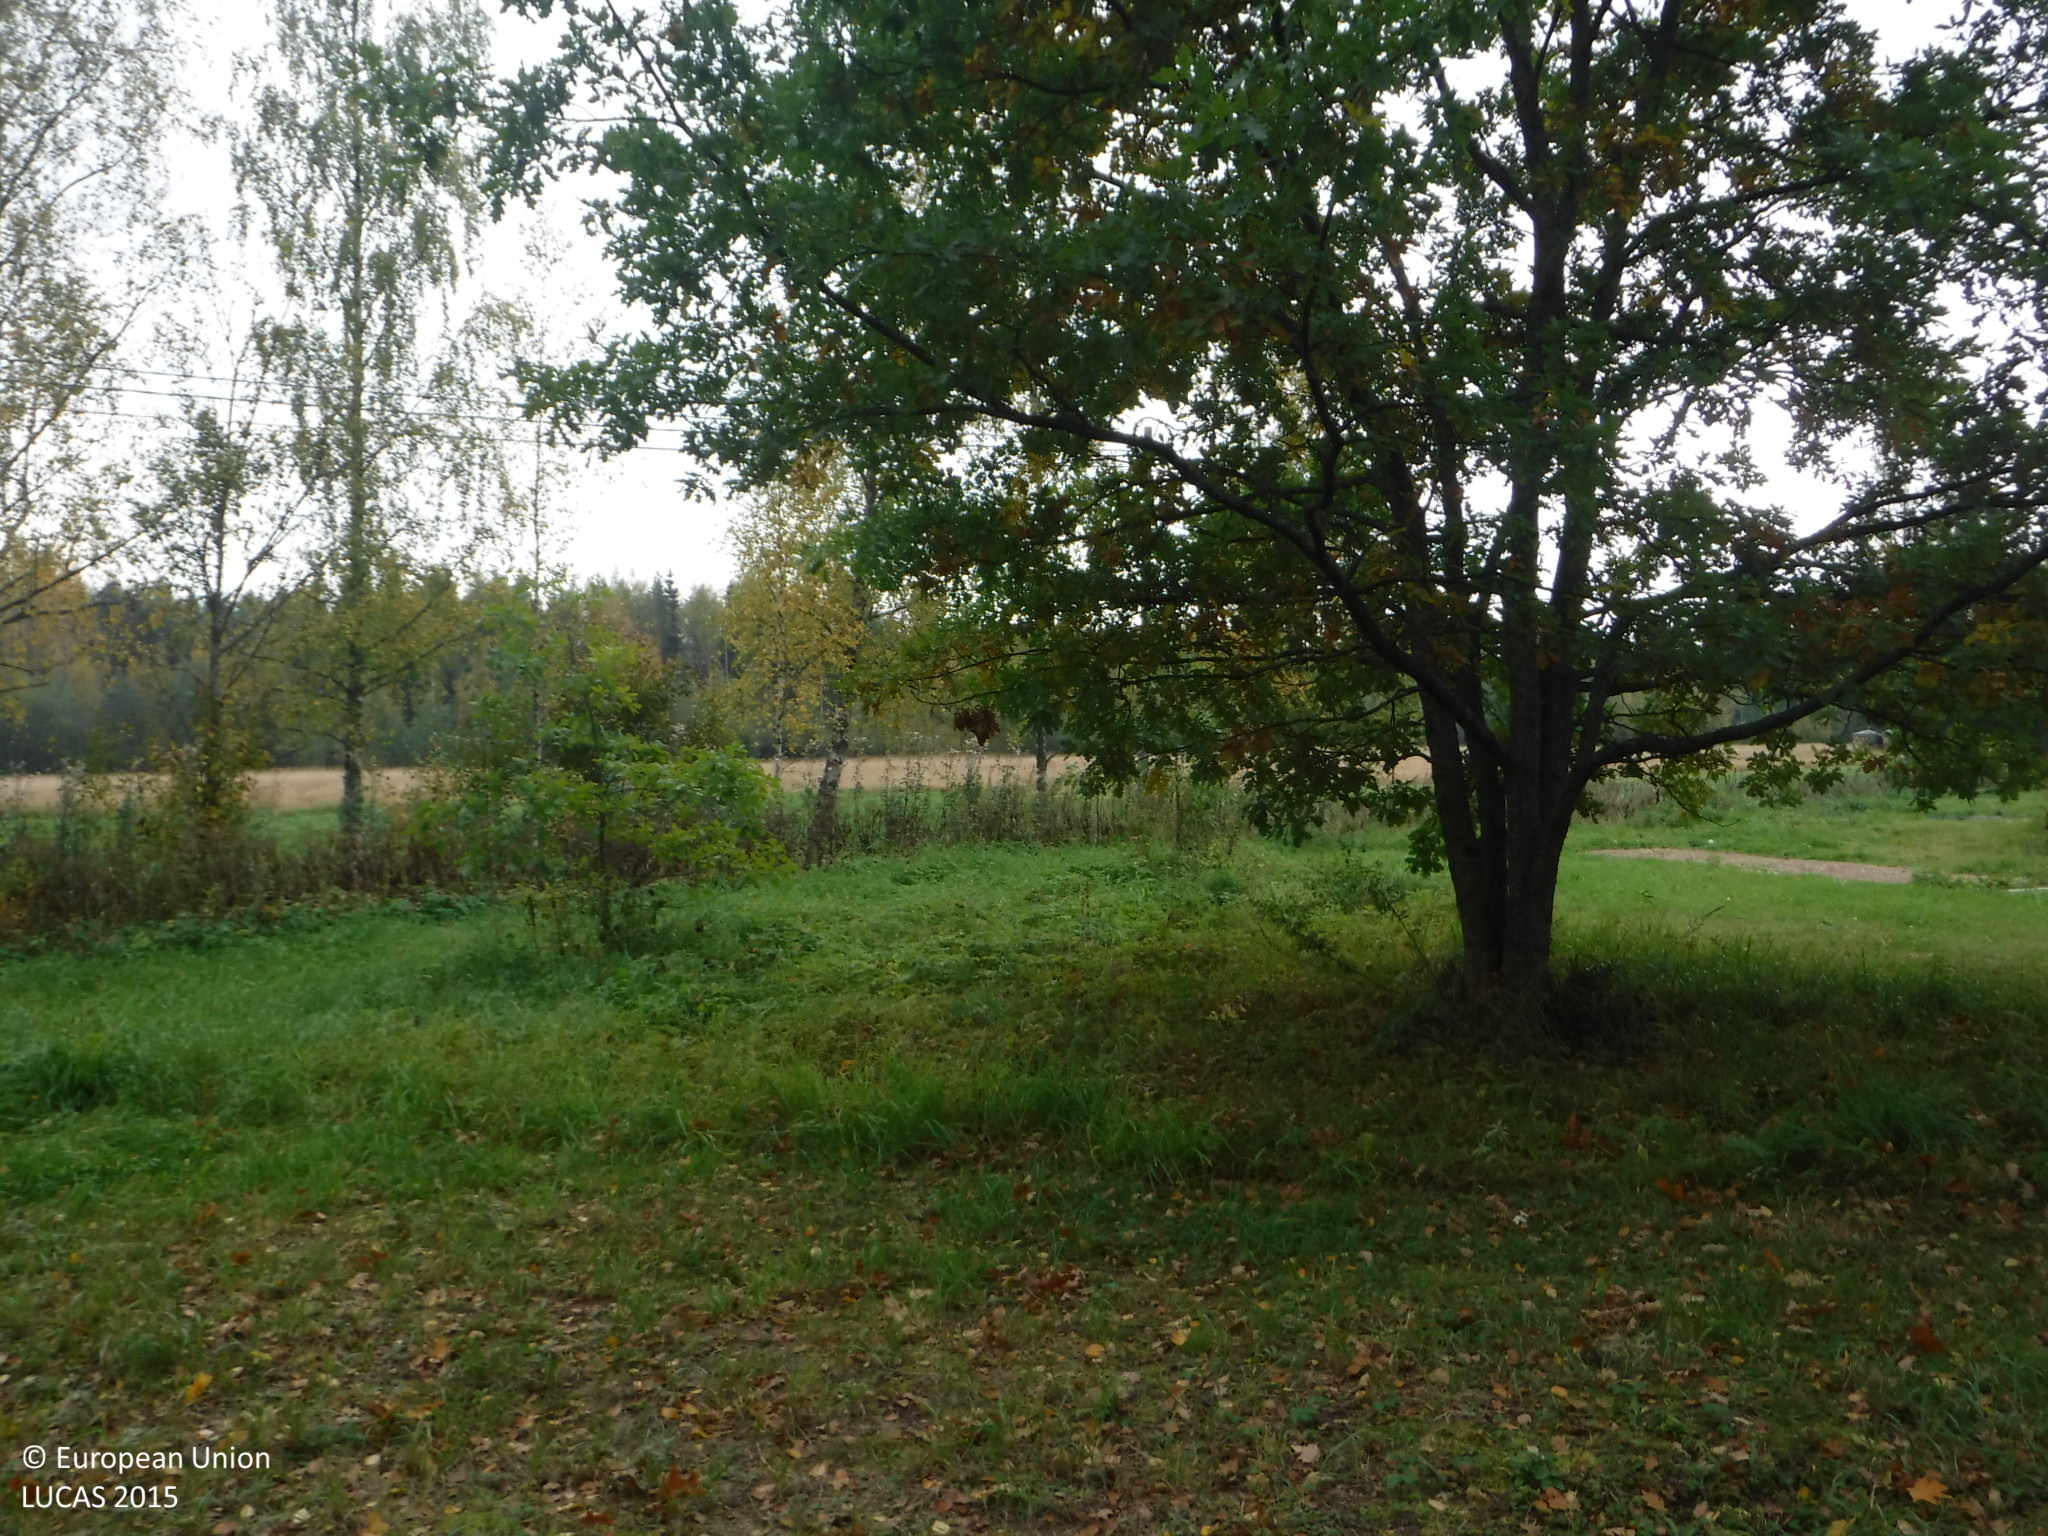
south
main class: Woodland
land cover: Pine dominated mixed woodland
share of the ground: 50 - 75 %
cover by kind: herbaceous plants 50 %, coniferous forest trees 25 %, broadleaved forest trees 25 %
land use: Residential
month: September
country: FI
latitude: 61.5858
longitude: 23.8178
